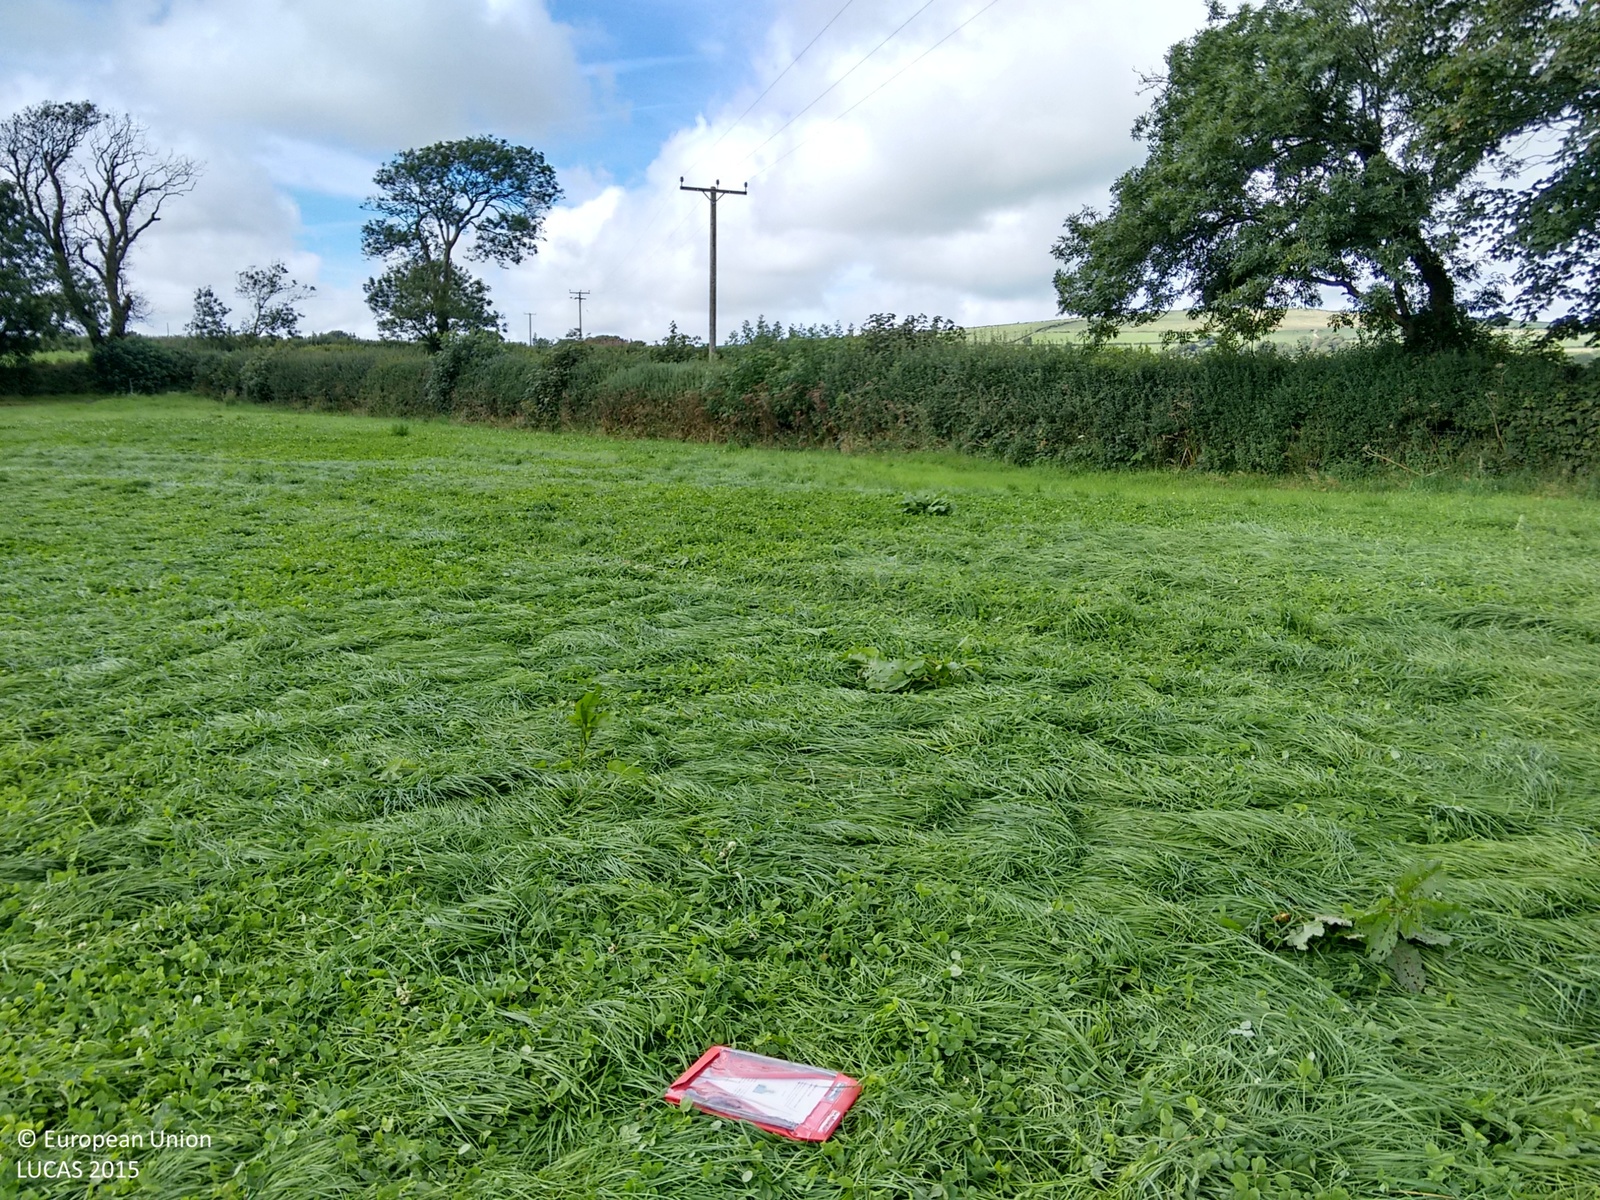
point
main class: Cropland
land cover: Temporary grasslands
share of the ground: > 75 %
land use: Agriculture (excluding fallow land and kitchen gardens)
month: August
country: GB
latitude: 51.9161
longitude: -4.9601
